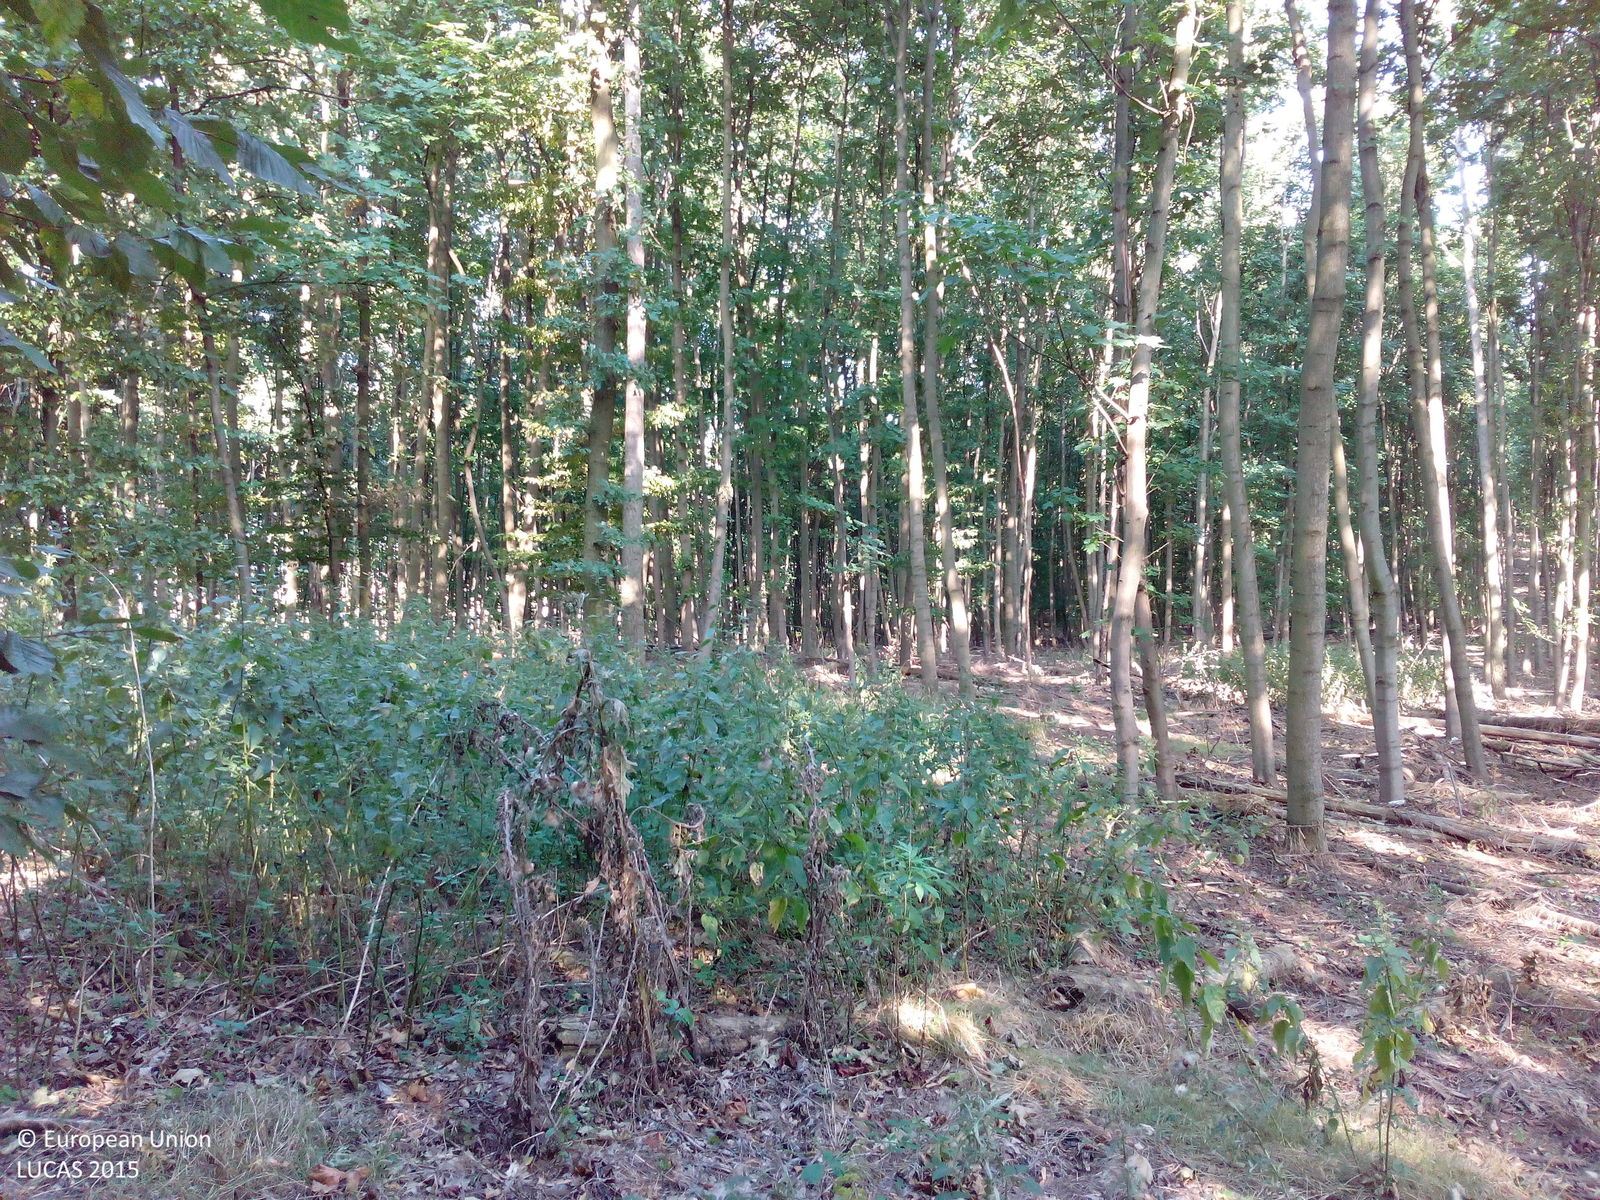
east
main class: Woodland
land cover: Broadleaved woodland
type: beech forest
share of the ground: > 75 %
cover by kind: broadleaved forest trees 90 %, shrubs 5 %, unconsolidated bare surface 5 %
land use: Forestry
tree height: > 5 m
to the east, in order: Broadleaved woodland; Common wheat
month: August
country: DE
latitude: 51.8509
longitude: 11.1175
